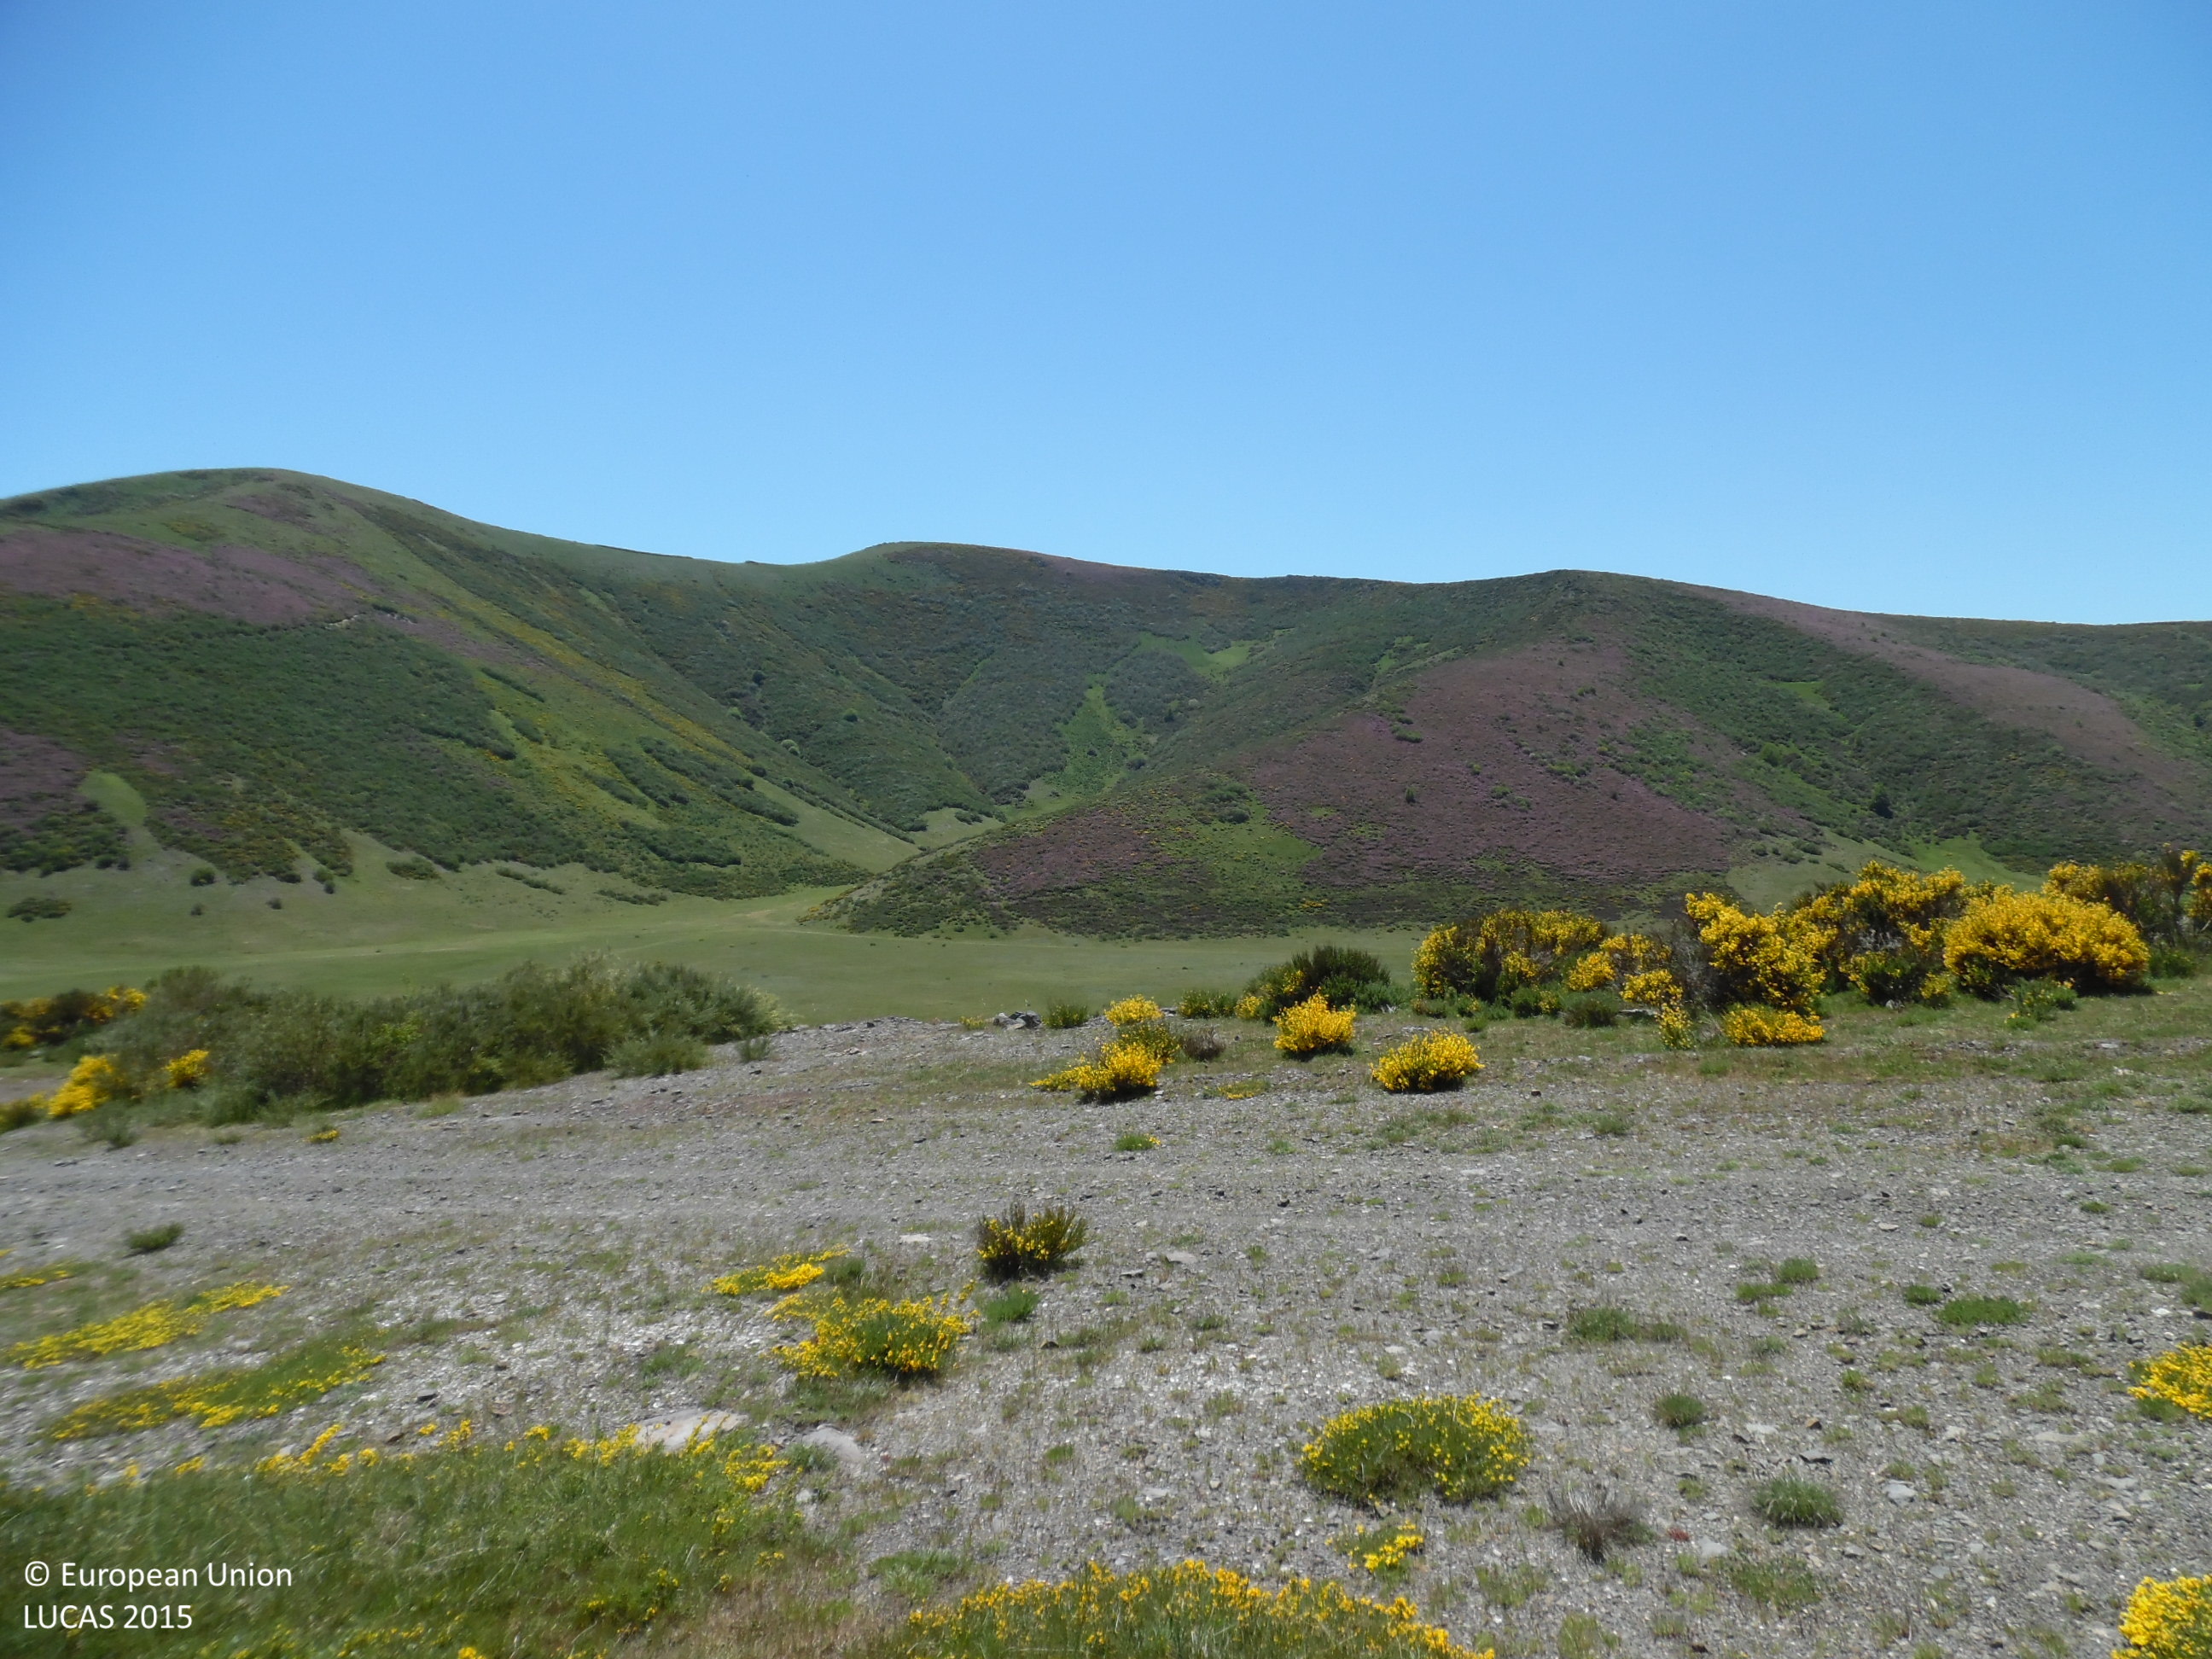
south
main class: Shrubland
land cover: Shrubland with sparse tree cover
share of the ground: 50 - 75 %
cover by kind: shrubs 95 %, broadleaved forest trees 5 %
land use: Other primary production
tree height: < 5 m
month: May
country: ES
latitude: 42.9203
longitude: -6.2005
